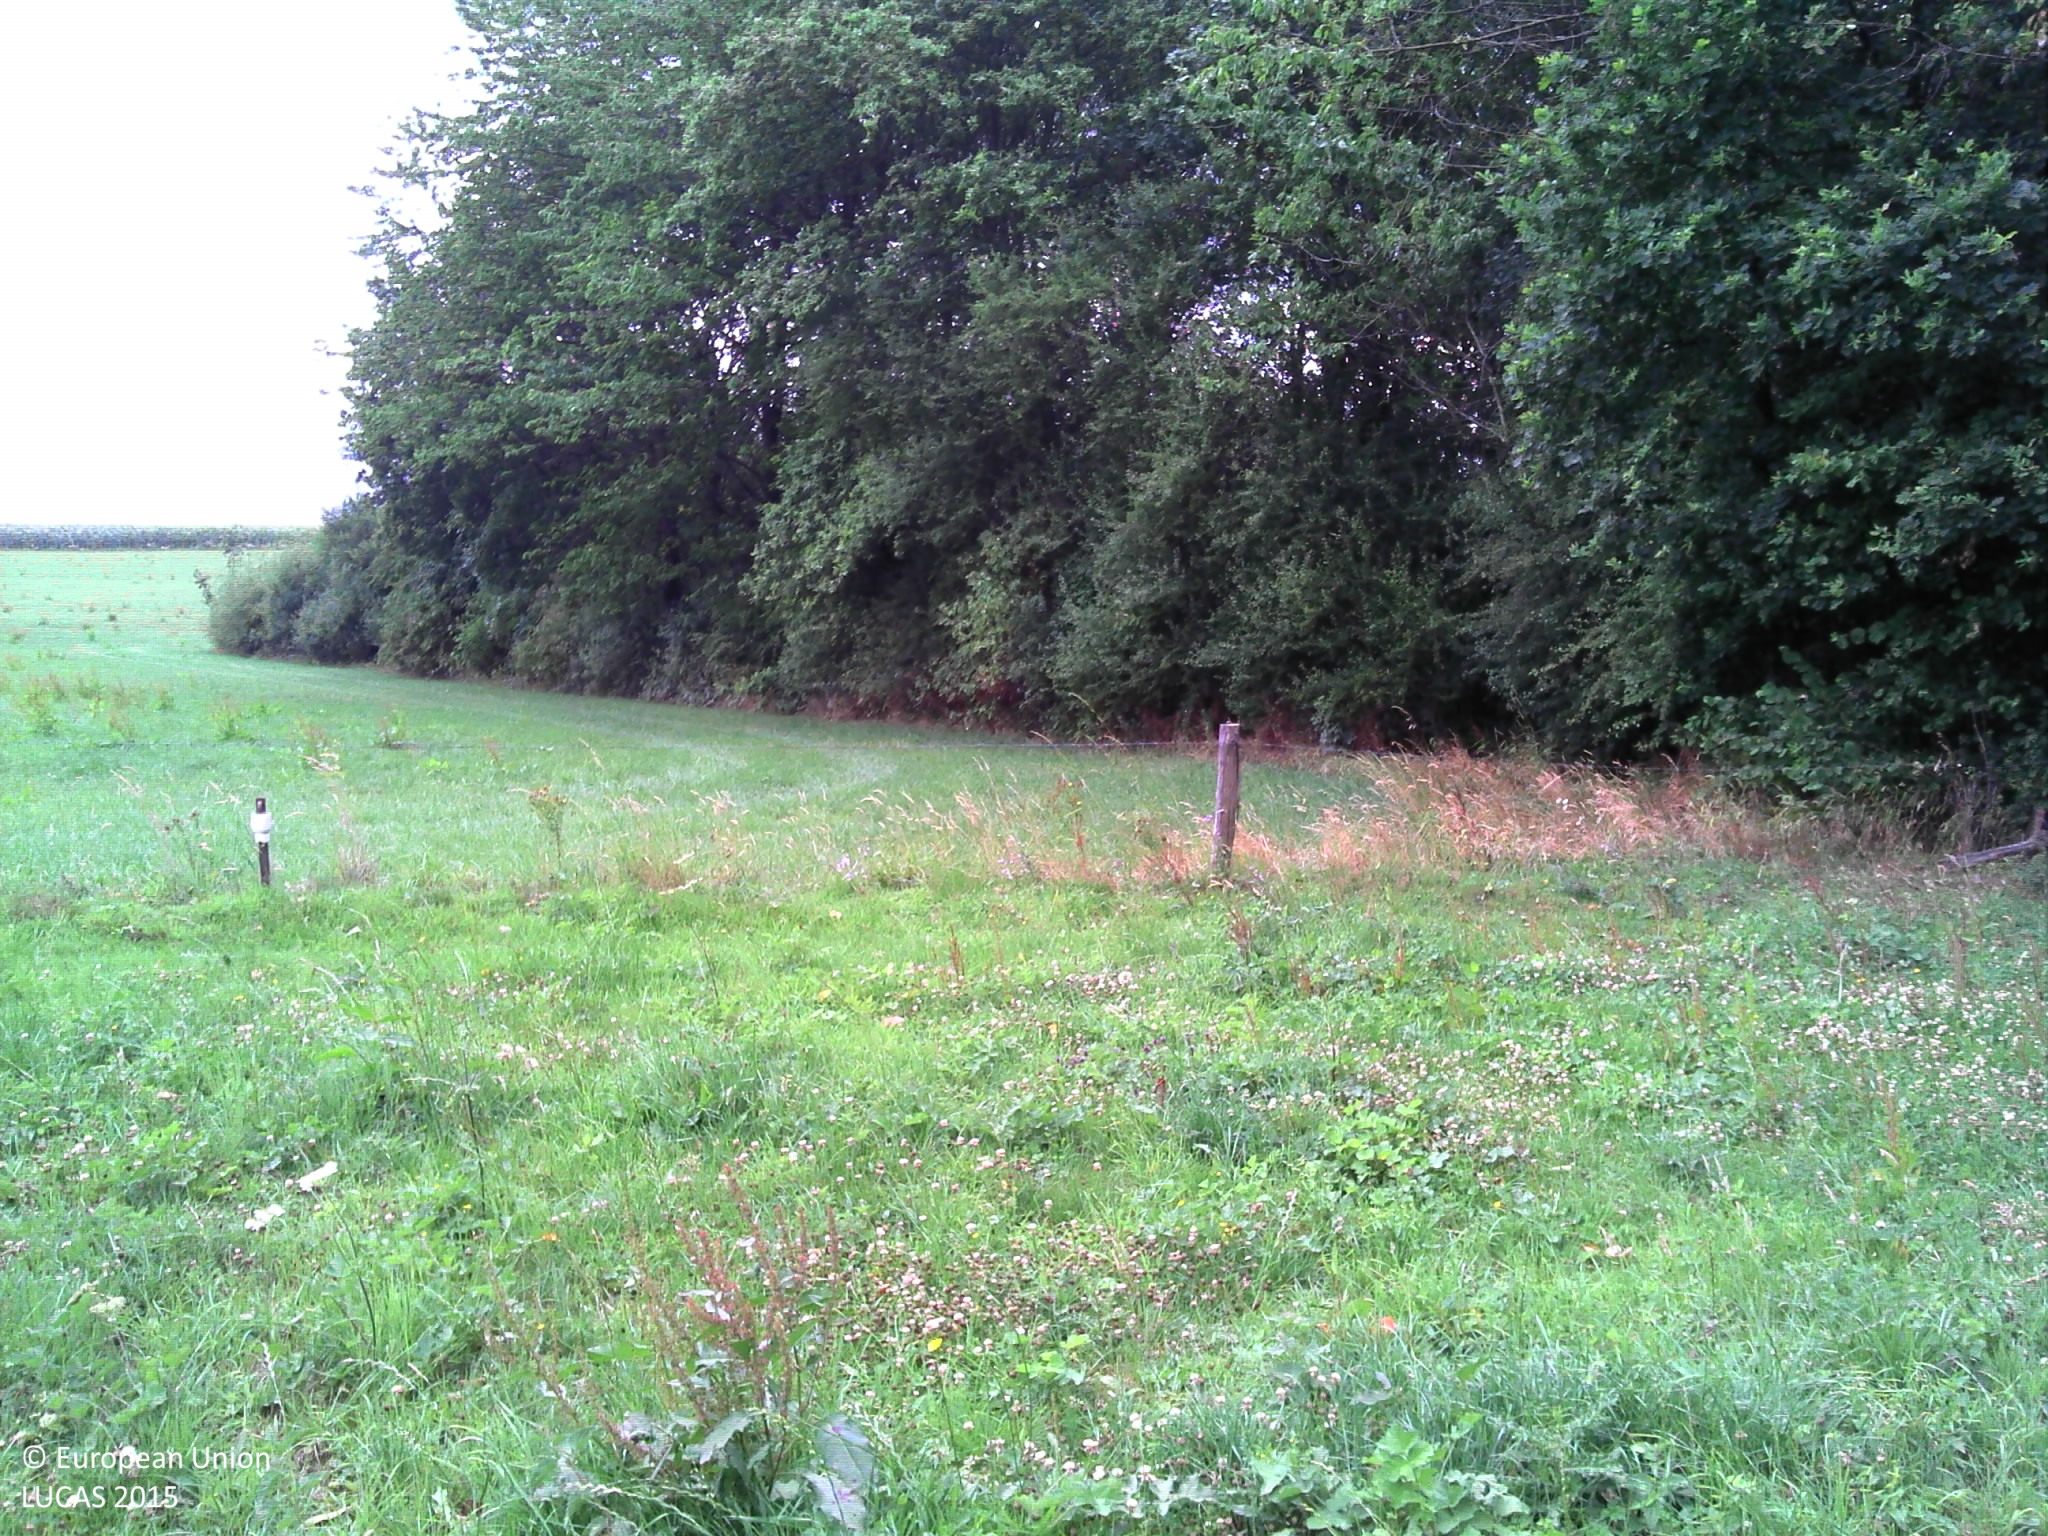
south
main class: Grassland
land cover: Grassland without tree/shrub cover
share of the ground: > 75 %
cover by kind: herbaceous plants 100 %
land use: Agriculture (excluding fallow land and kitchen gardens)
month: July
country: BE
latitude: 49.6167
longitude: 5.6942
